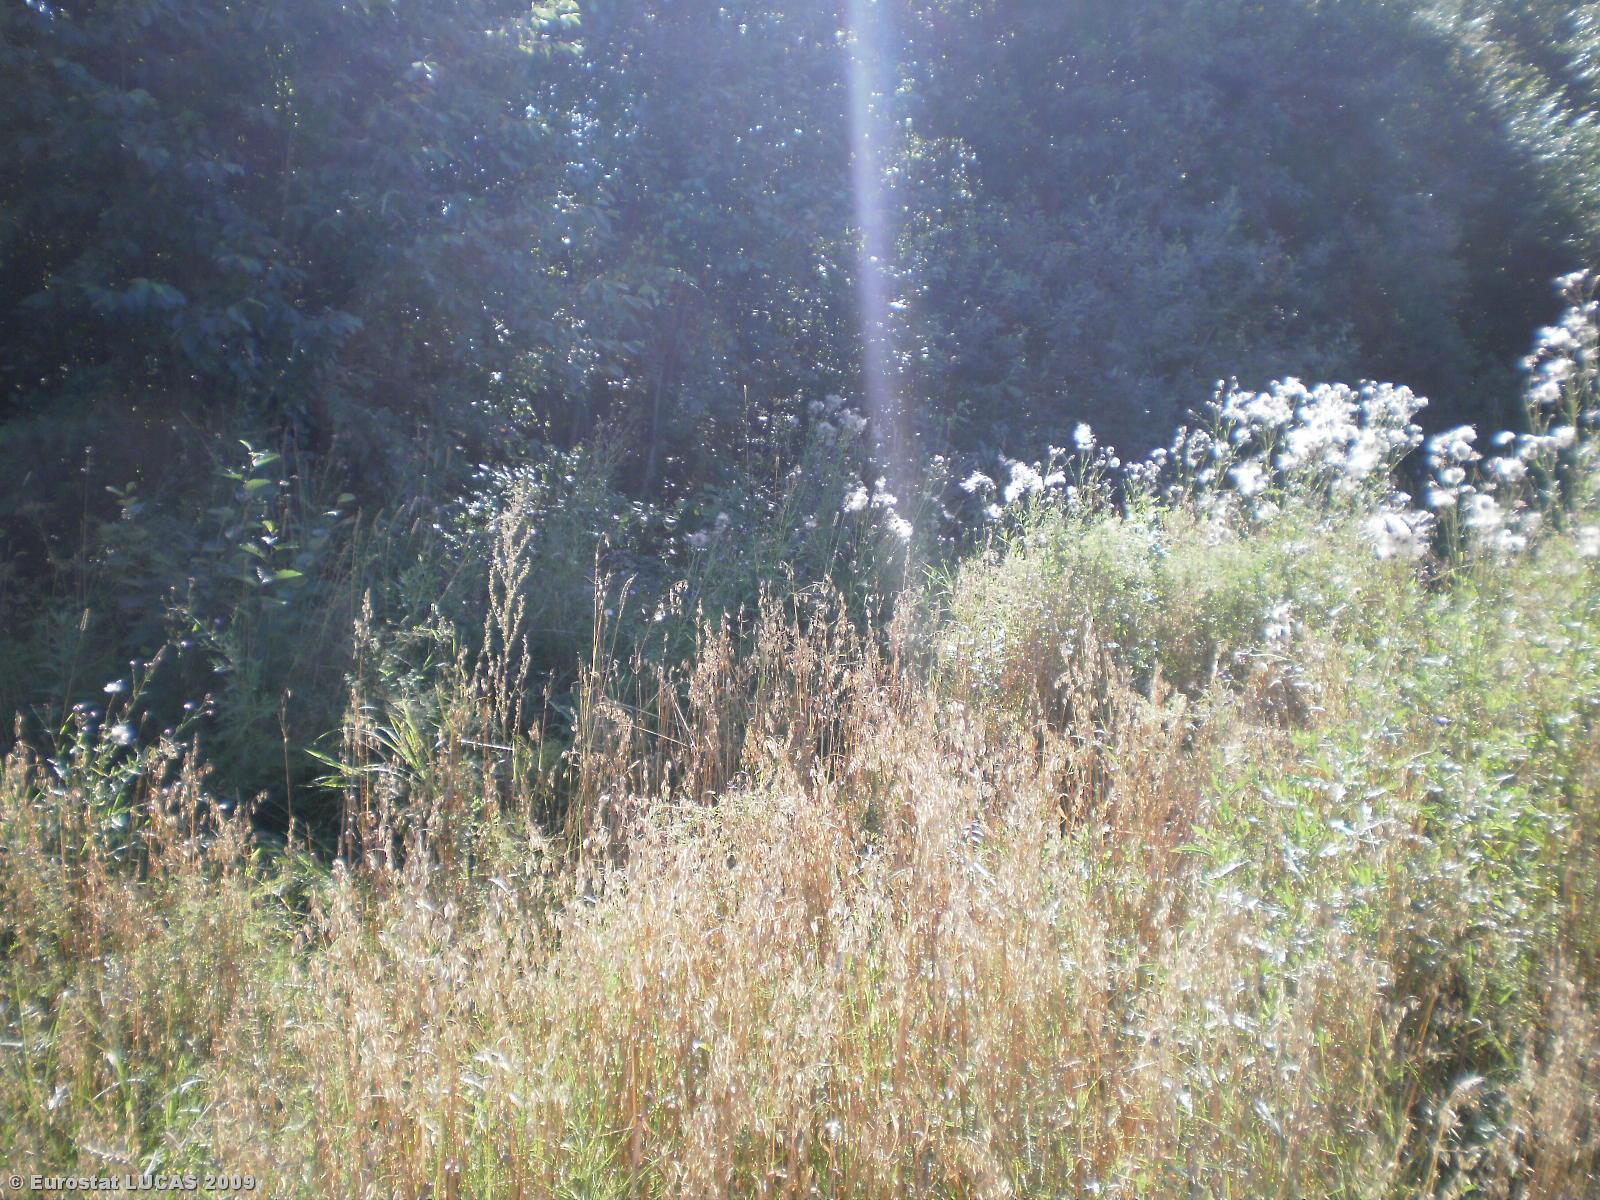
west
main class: Cropland
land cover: Oats
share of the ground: > 75 %
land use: Agriculture (excluding fallow land and kitchen gardens)
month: August
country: LT
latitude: 54.9070
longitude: 24.7533
